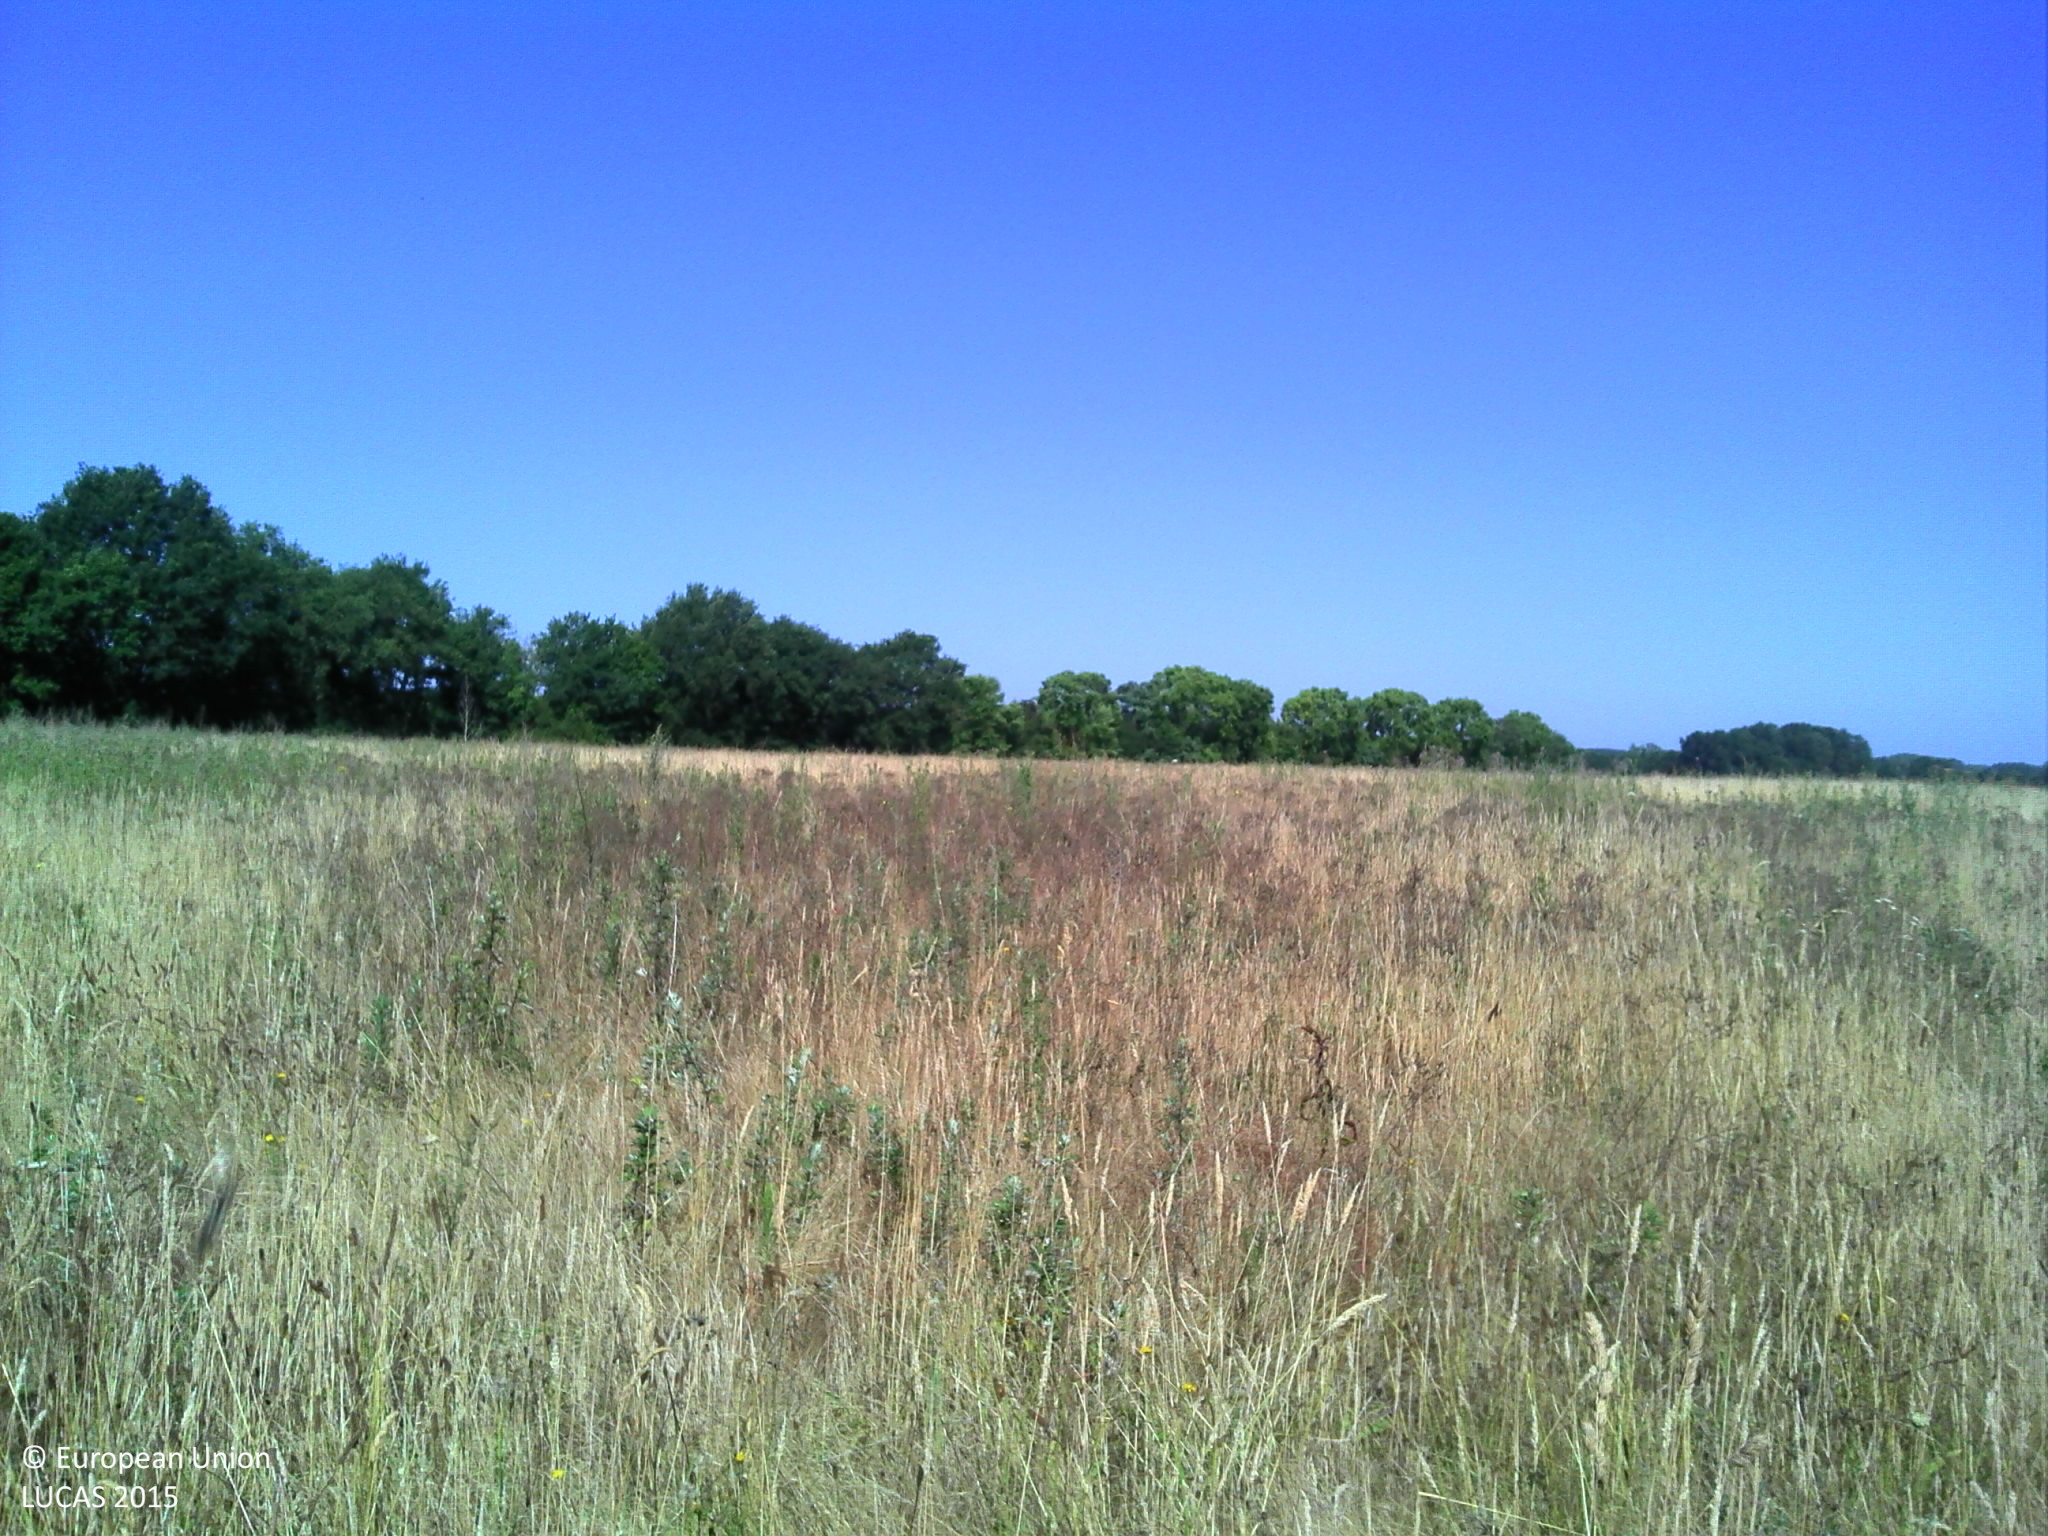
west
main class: Grassland
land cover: Grassland without tree/shrub cover
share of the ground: > 75 %
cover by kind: herbaceous plants 100 %
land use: Agriculture (excluding fallow land and kitchen gardens)
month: July
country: FR
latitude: 47.6473
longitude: 0.2712
